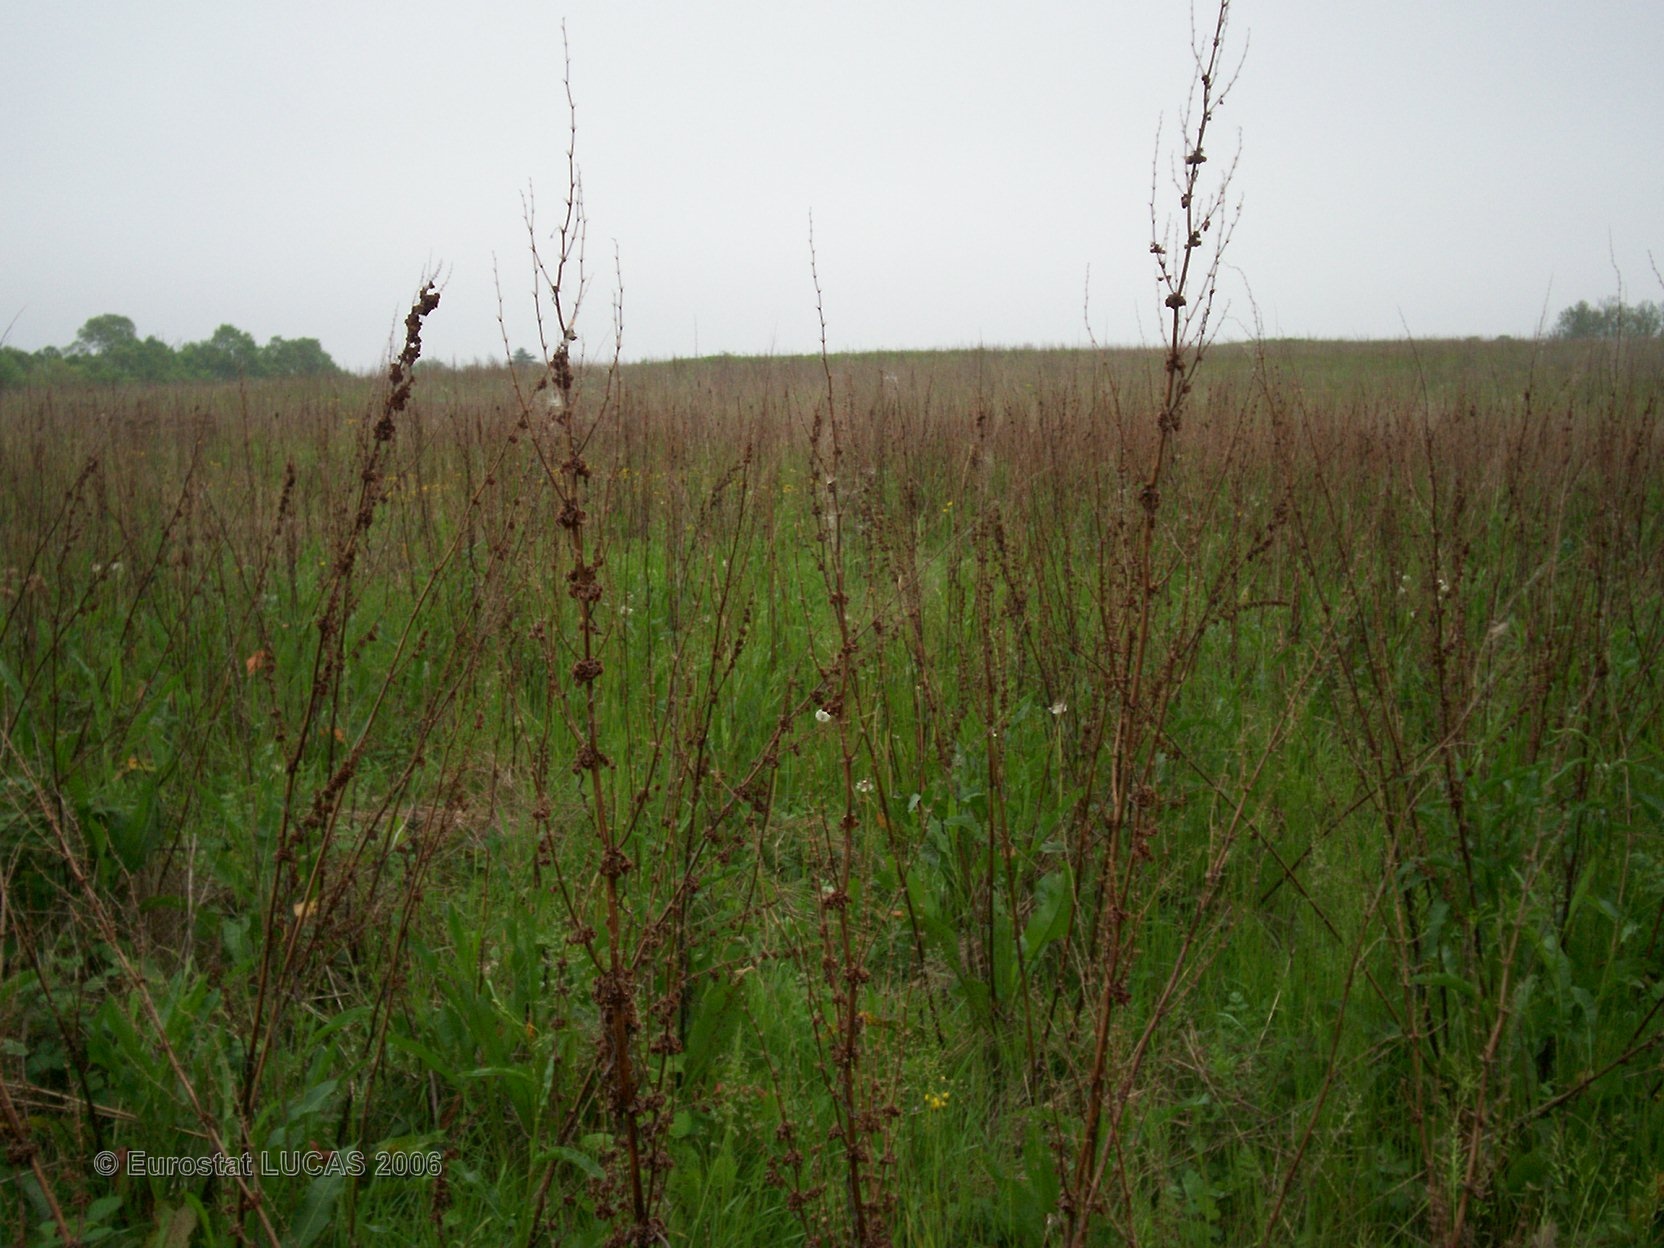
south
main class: Grassland
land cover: Grassland without tree/shrub cover
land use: Fallow land
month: April
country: FR
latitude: 44.2039
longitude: 0.8989
